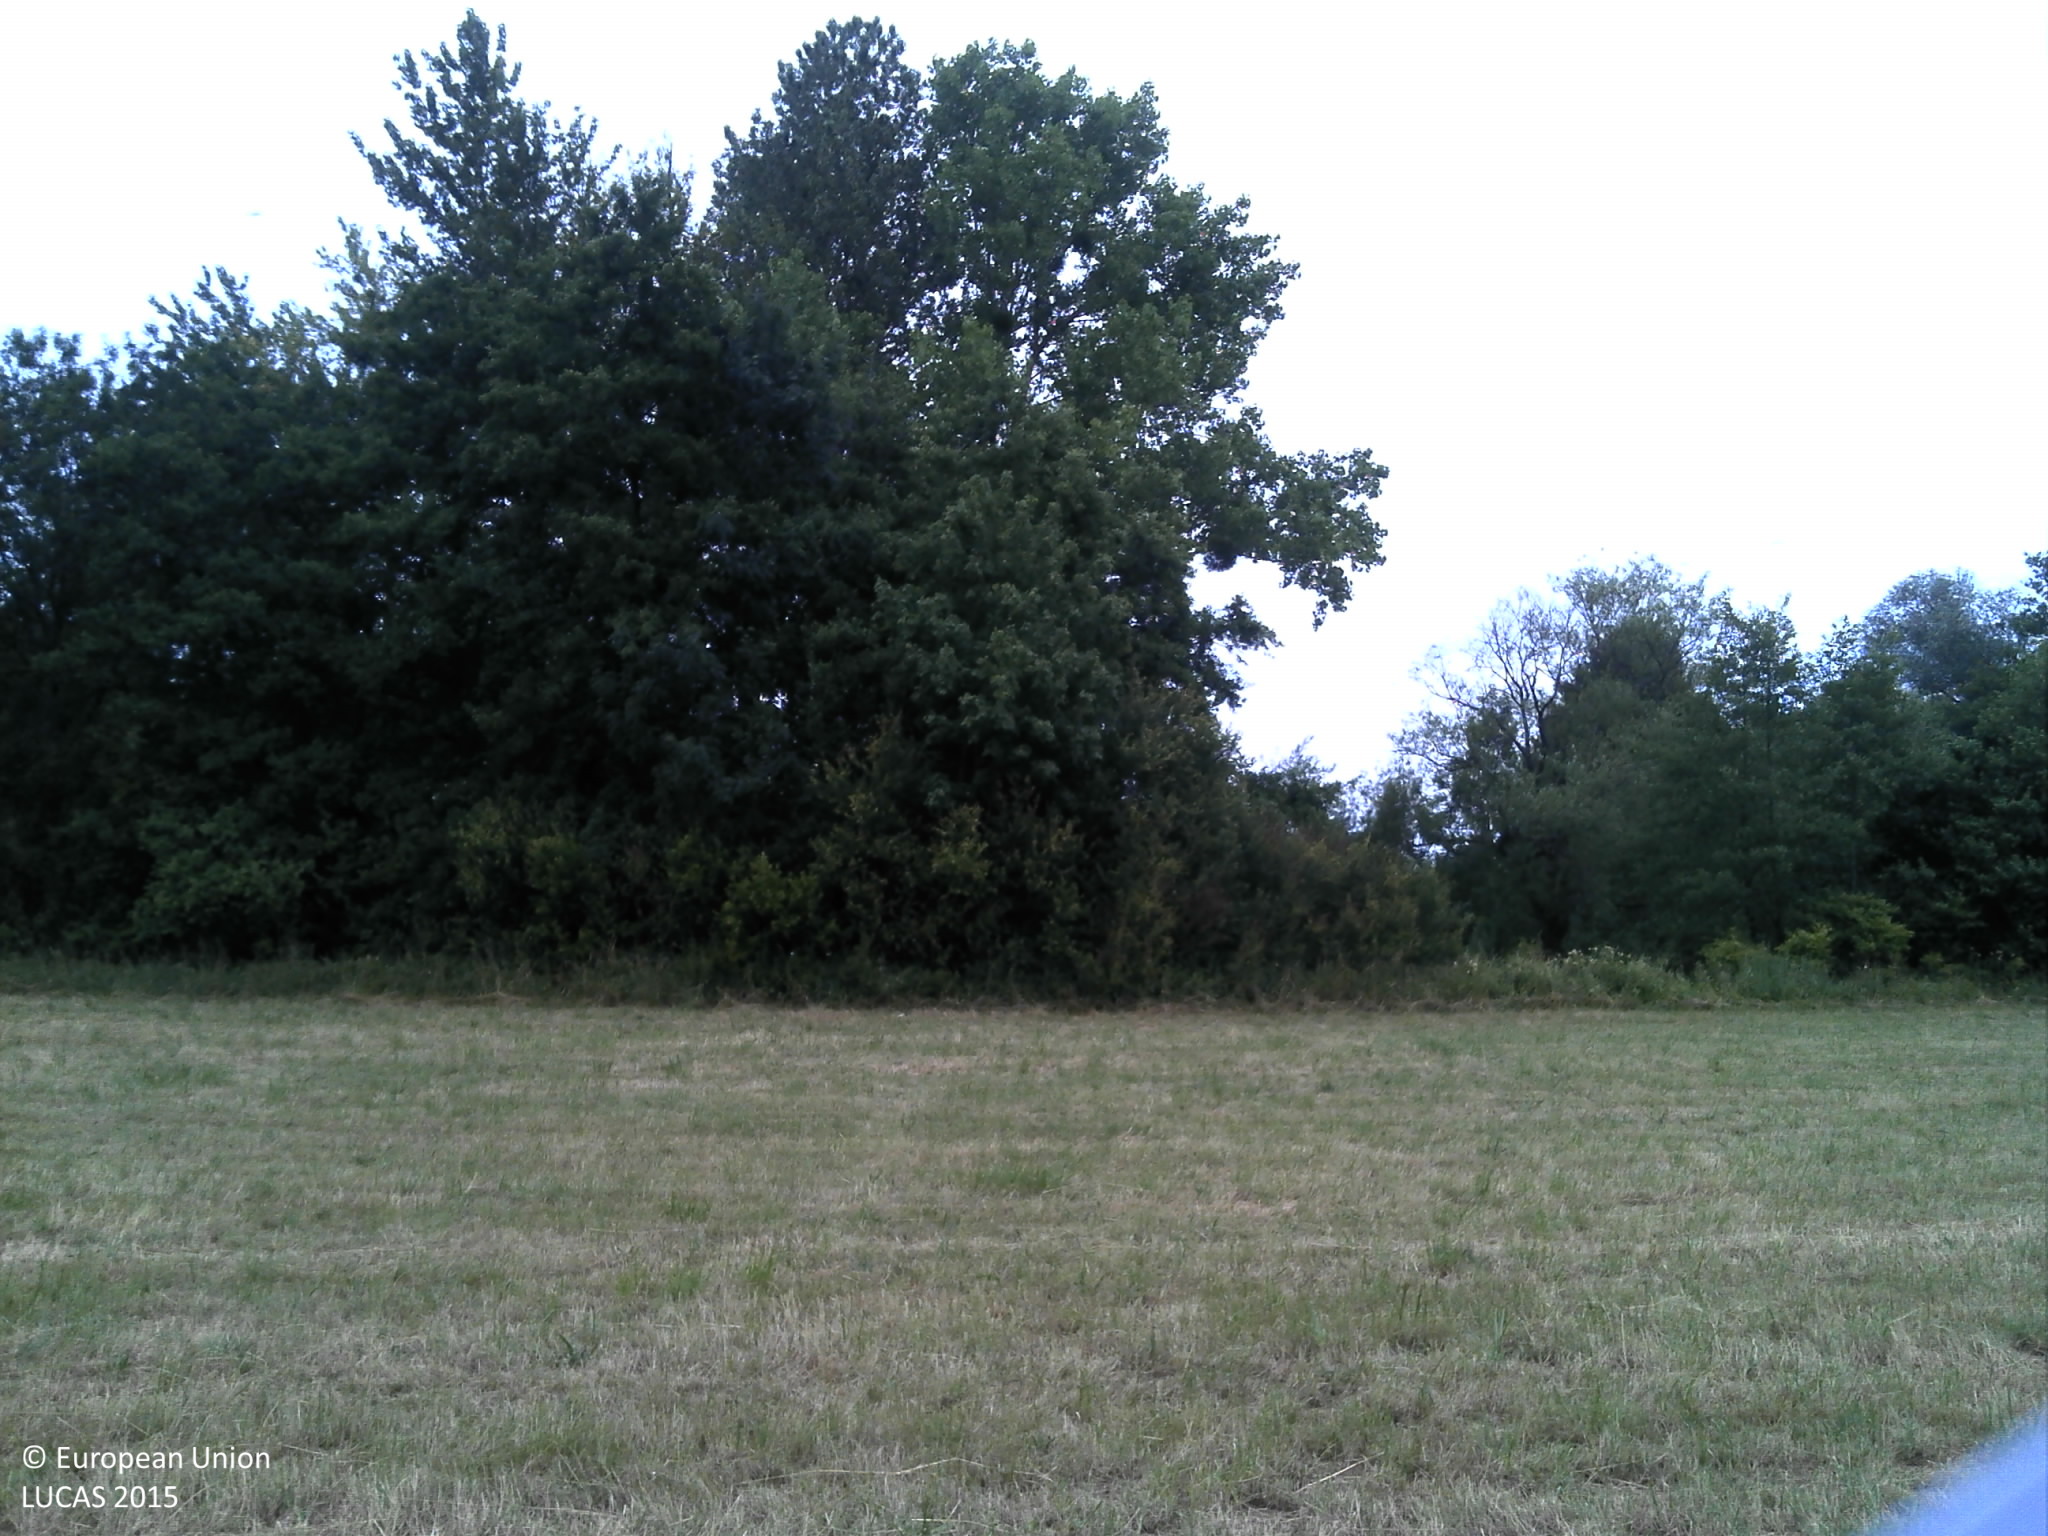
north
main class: Grassland
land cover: Grassland without tree/shrub cover
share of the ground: > 75 %
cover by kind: herbaceous plants 100 %
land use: Agriculture (excluding fallow land and kitchen gardens)
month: July
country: FR
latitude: 49.7717
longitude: 4.6785
